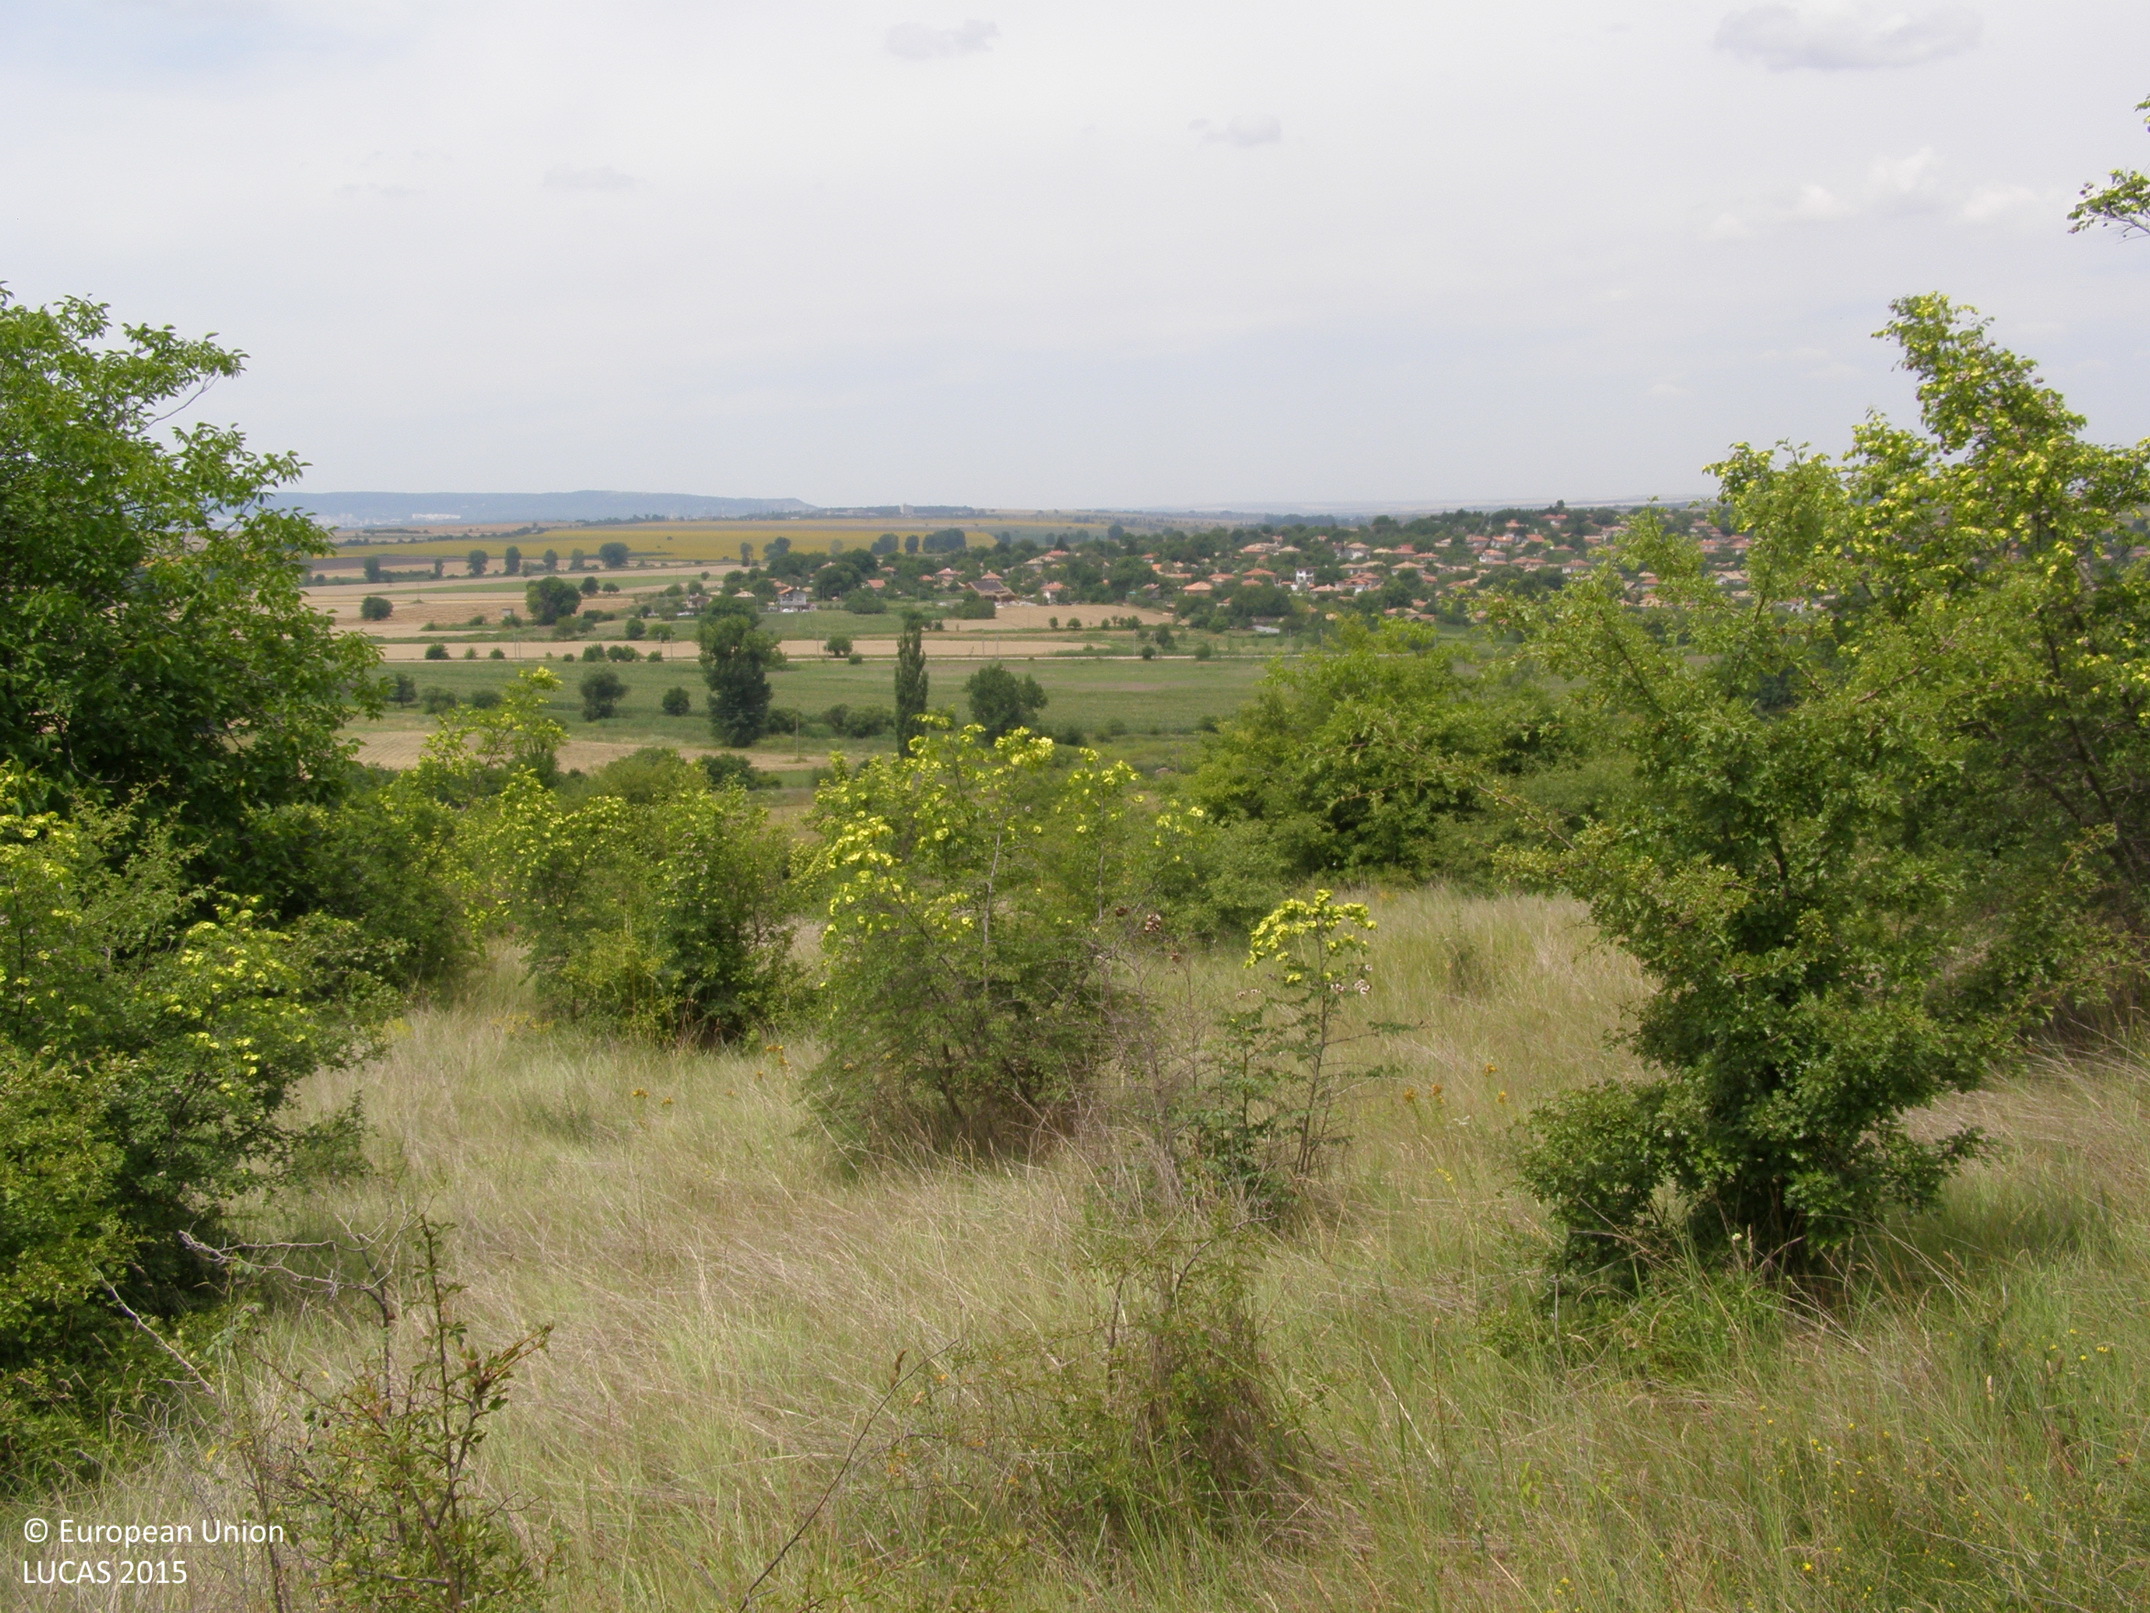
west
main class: Grassland
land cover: Grassland with sparse tree/shrub cover
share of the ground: > 75 %
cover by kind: herbaceous plants 85 %, shrubs 10 %, broadleaved forest trees 5 %
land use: Abandoned areas
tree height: < 5 m
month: July
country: BG
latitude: 43.2668
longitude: 27.1069
